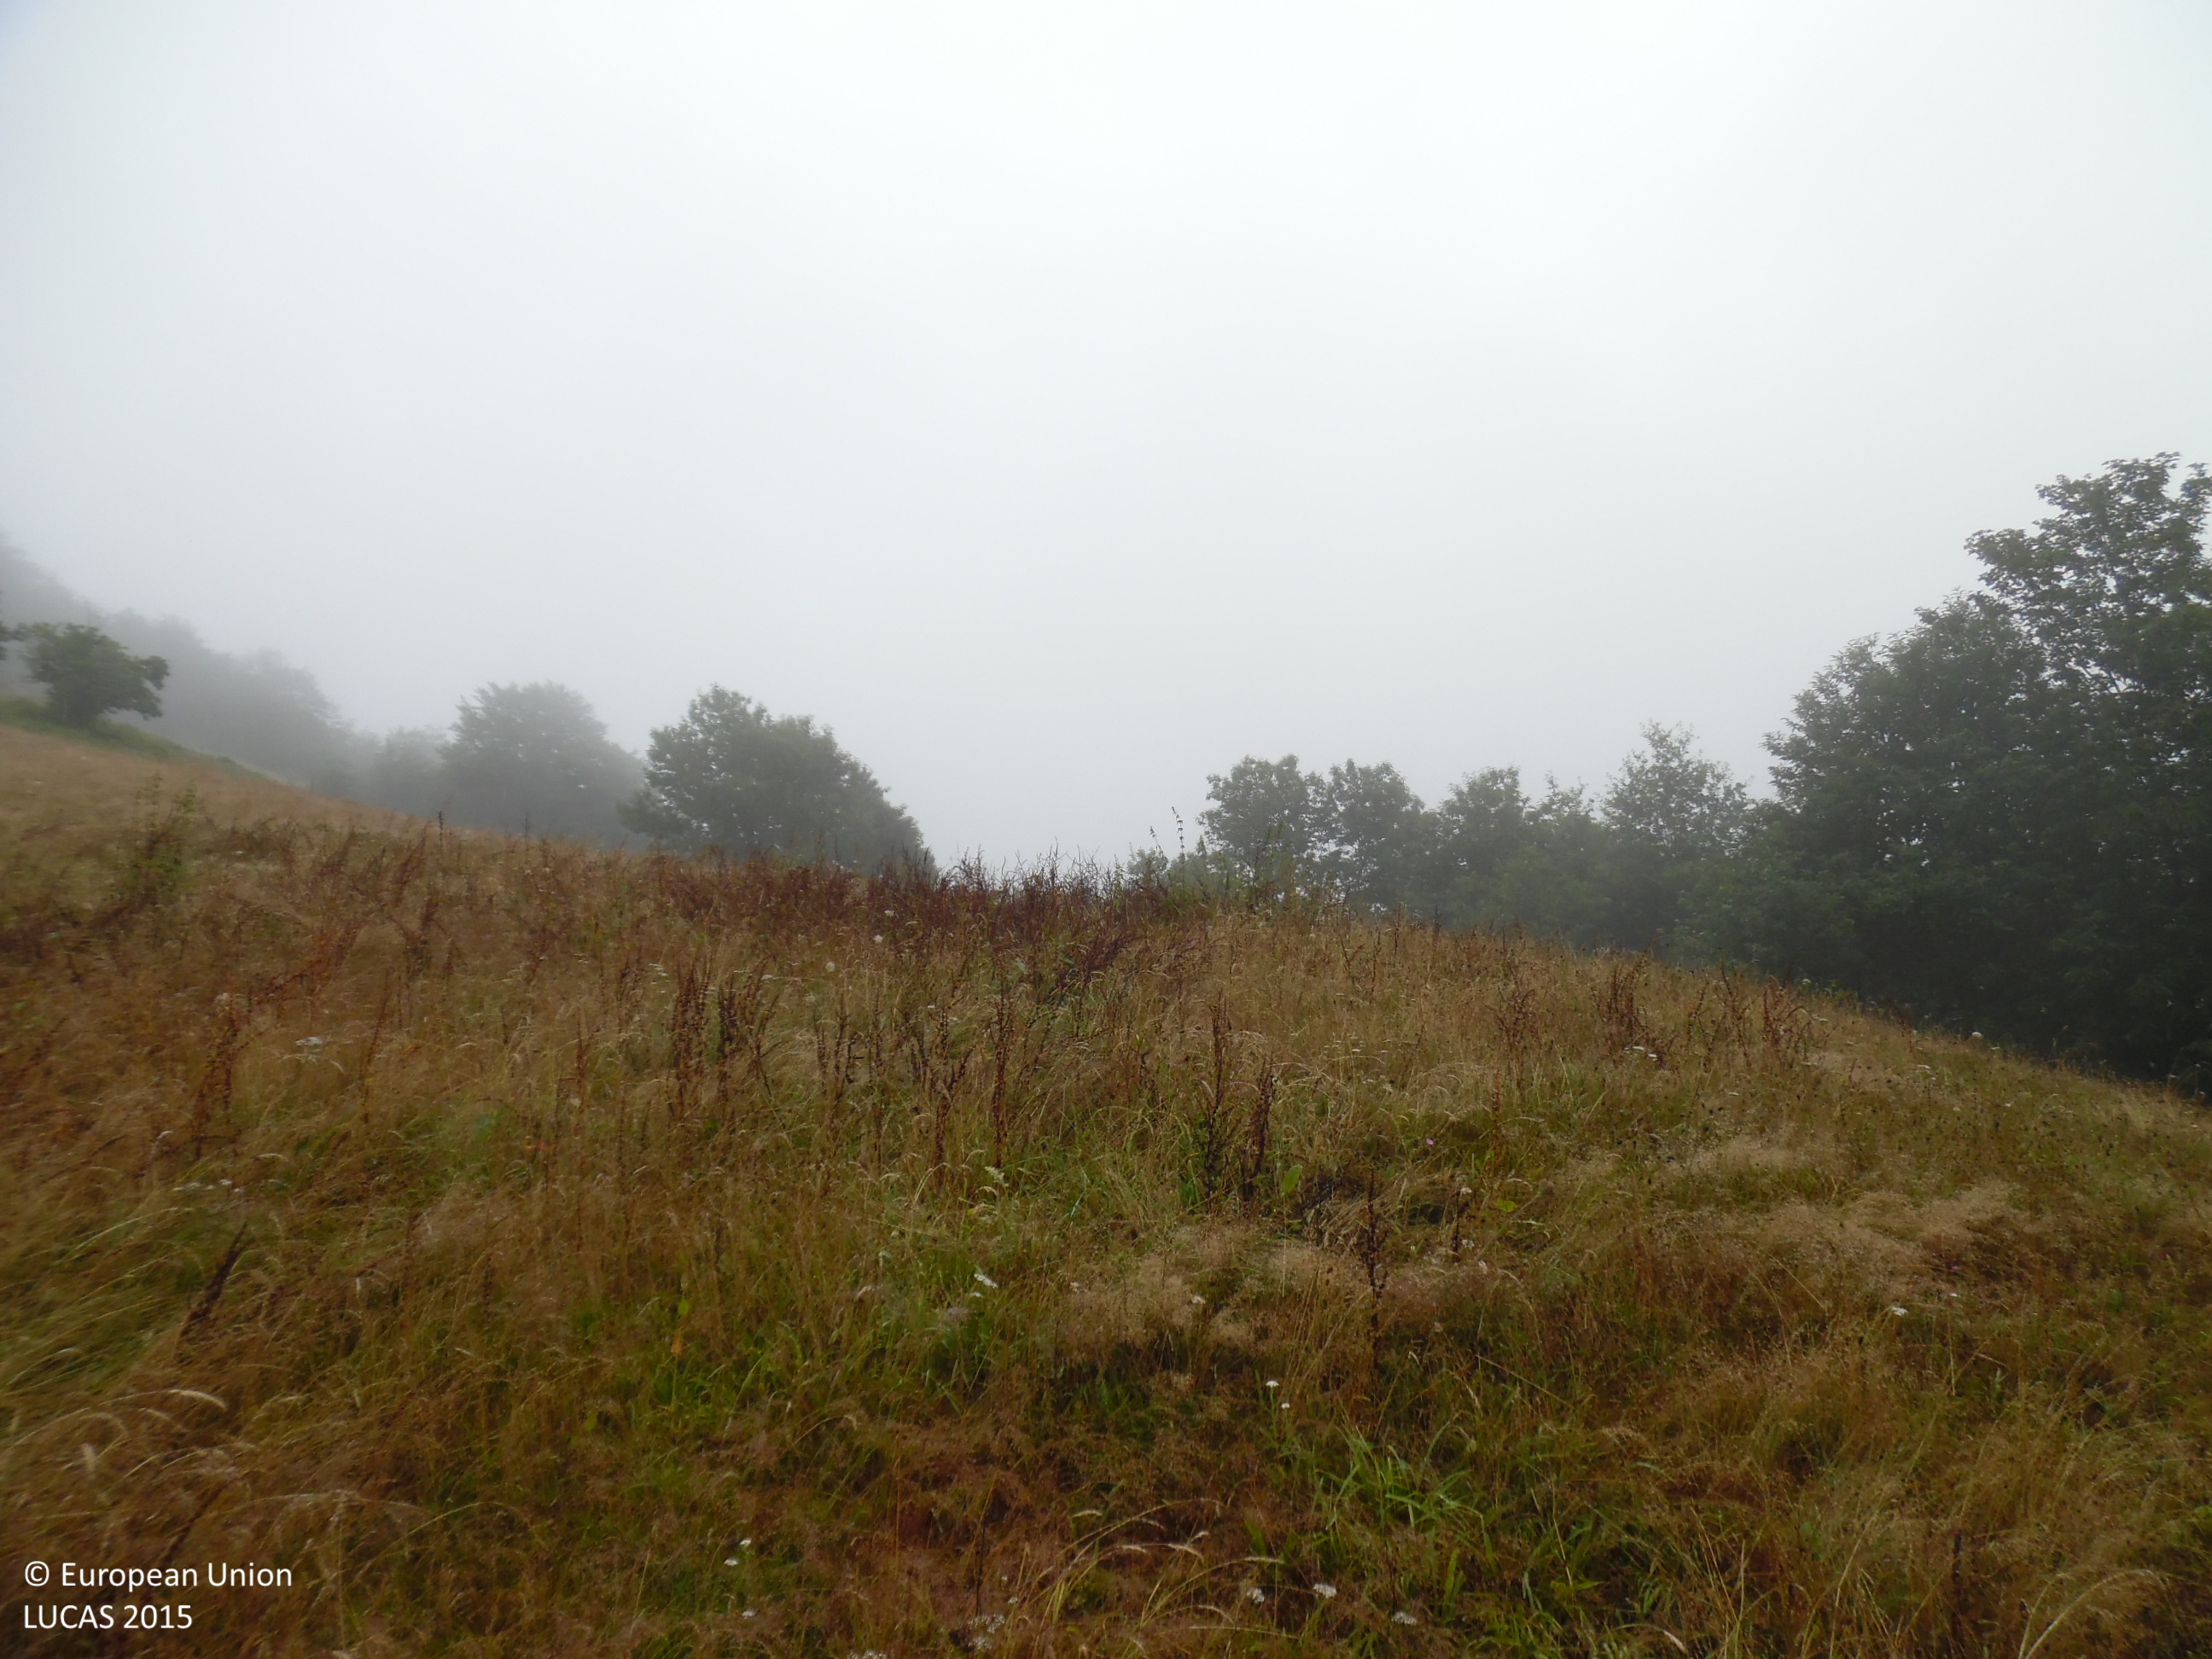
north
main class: Grassland
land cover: Grassland without tree/shrub cover
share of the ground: > 75 %
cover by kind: herbaceous plants 100 %
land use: Agriculture (excluding fallow land and kitchen gardens)
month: July
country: ES
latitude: 43.1361
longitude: -5.8835
